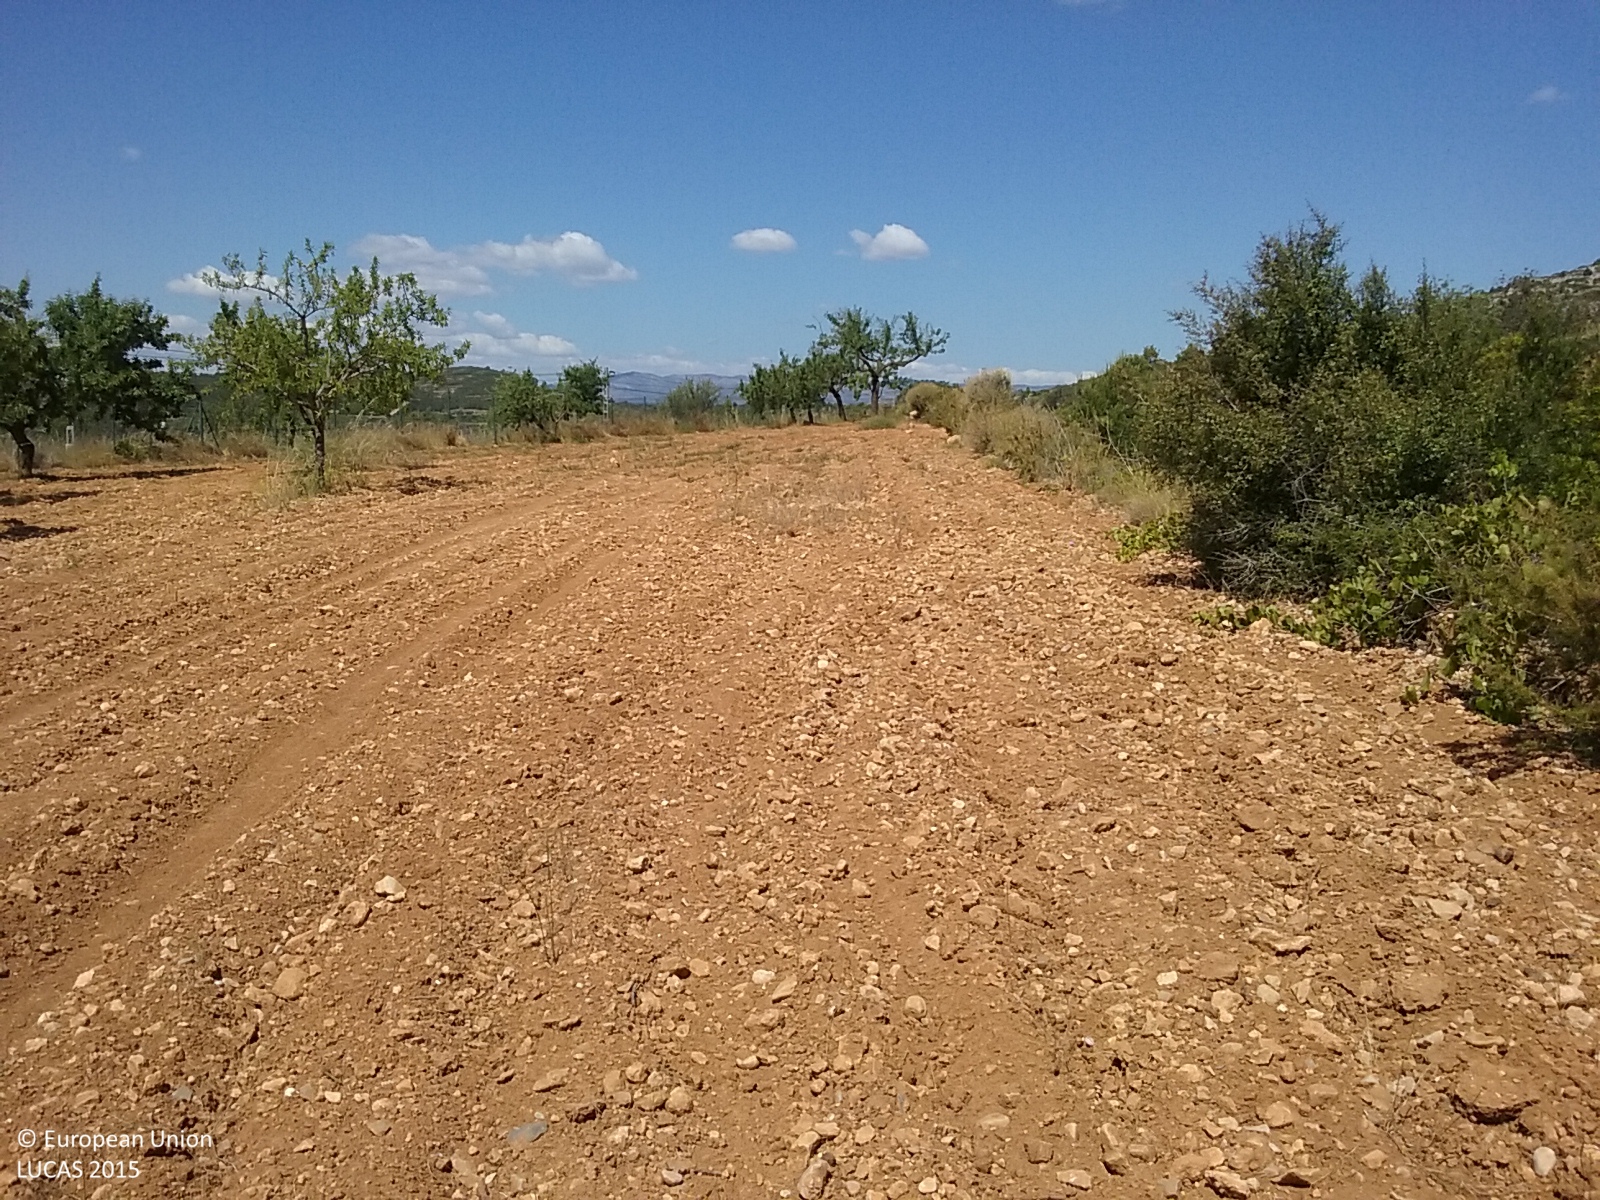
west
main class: Cropland
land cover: Nuts trees
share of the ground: < 10 %
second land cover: Other bare soil
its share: > 75 %
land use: Agriculture (excluding fallow land and kitchen gardens)
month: May
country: ES
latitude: 40.2721
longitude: 0.2484
